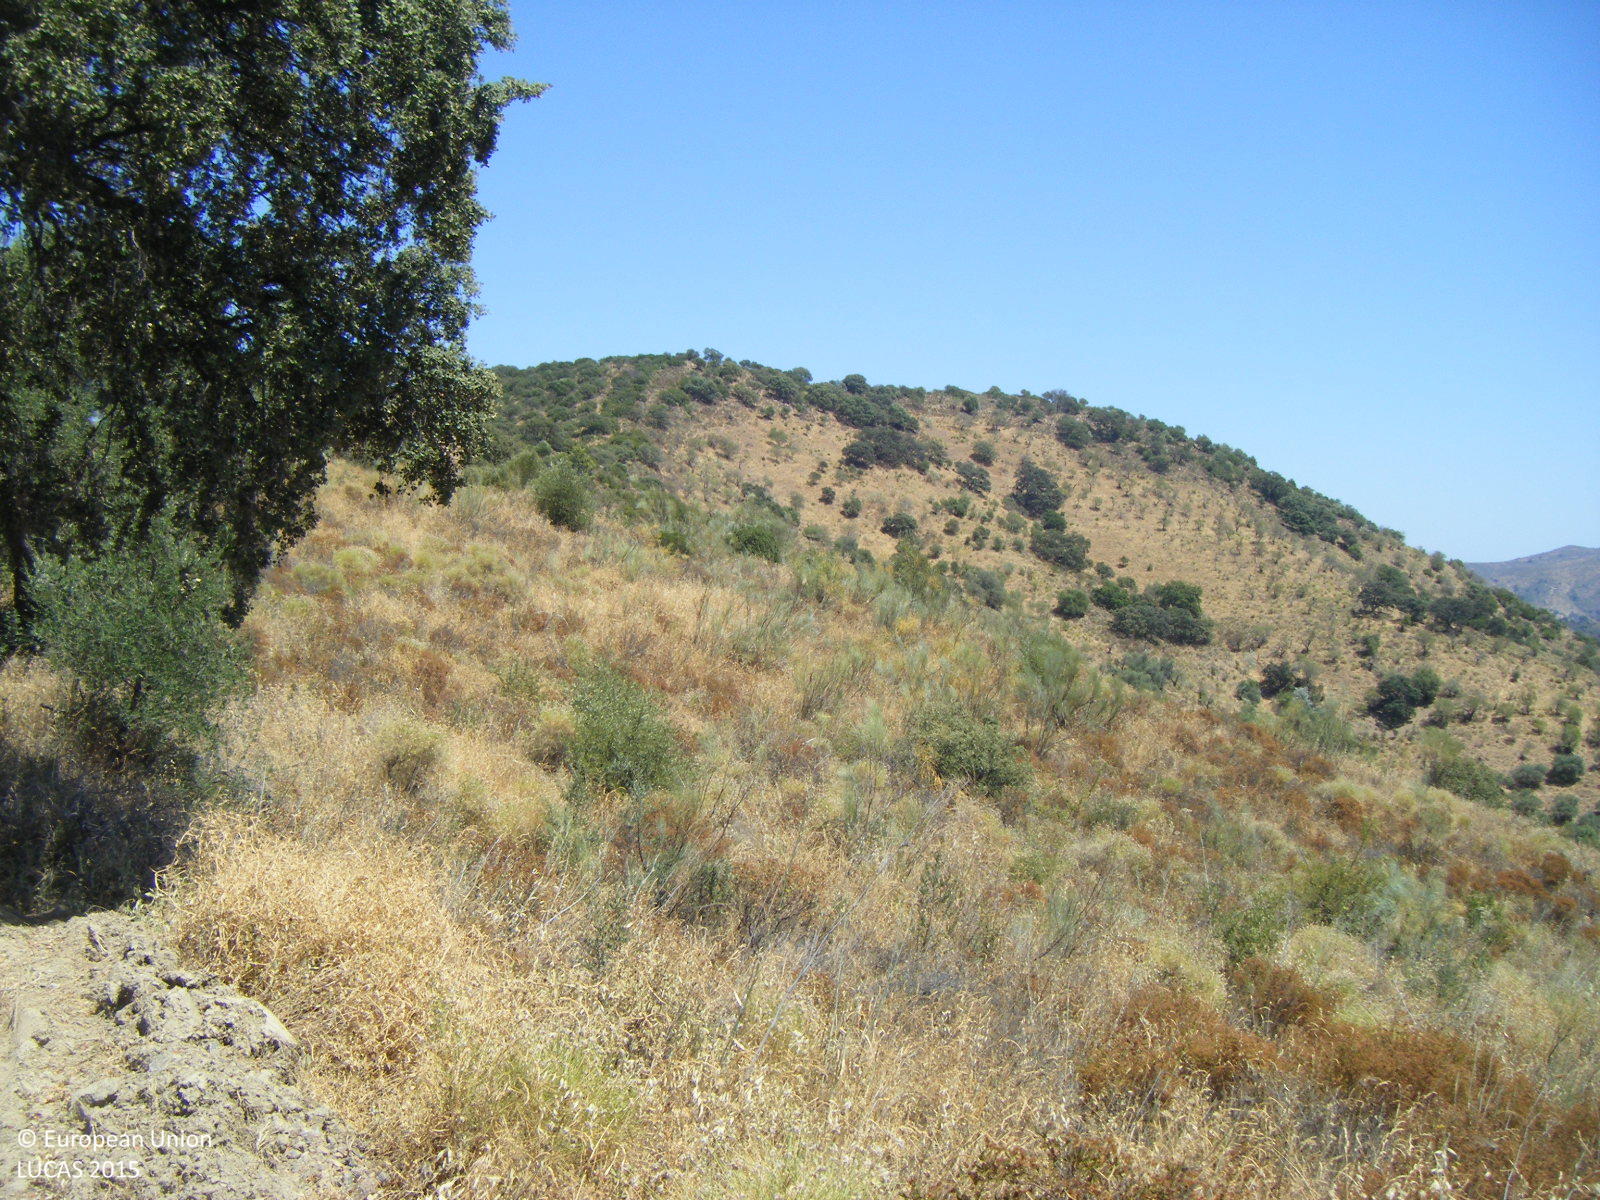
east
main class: Cropland
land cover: Nuts trees
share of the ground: 10 - 25 %
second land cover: Spontaneously vegetated surfaces
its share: > 75 %
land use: Abandoned areas
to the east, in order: Nuts trees; Spontaneously vegetated surfaces; Shrubland with sparse tree cover; Shrubland without tree cover; Shrubland with sparse tree cover
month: July
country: ES
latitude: 36.8395
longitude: -4.3330
